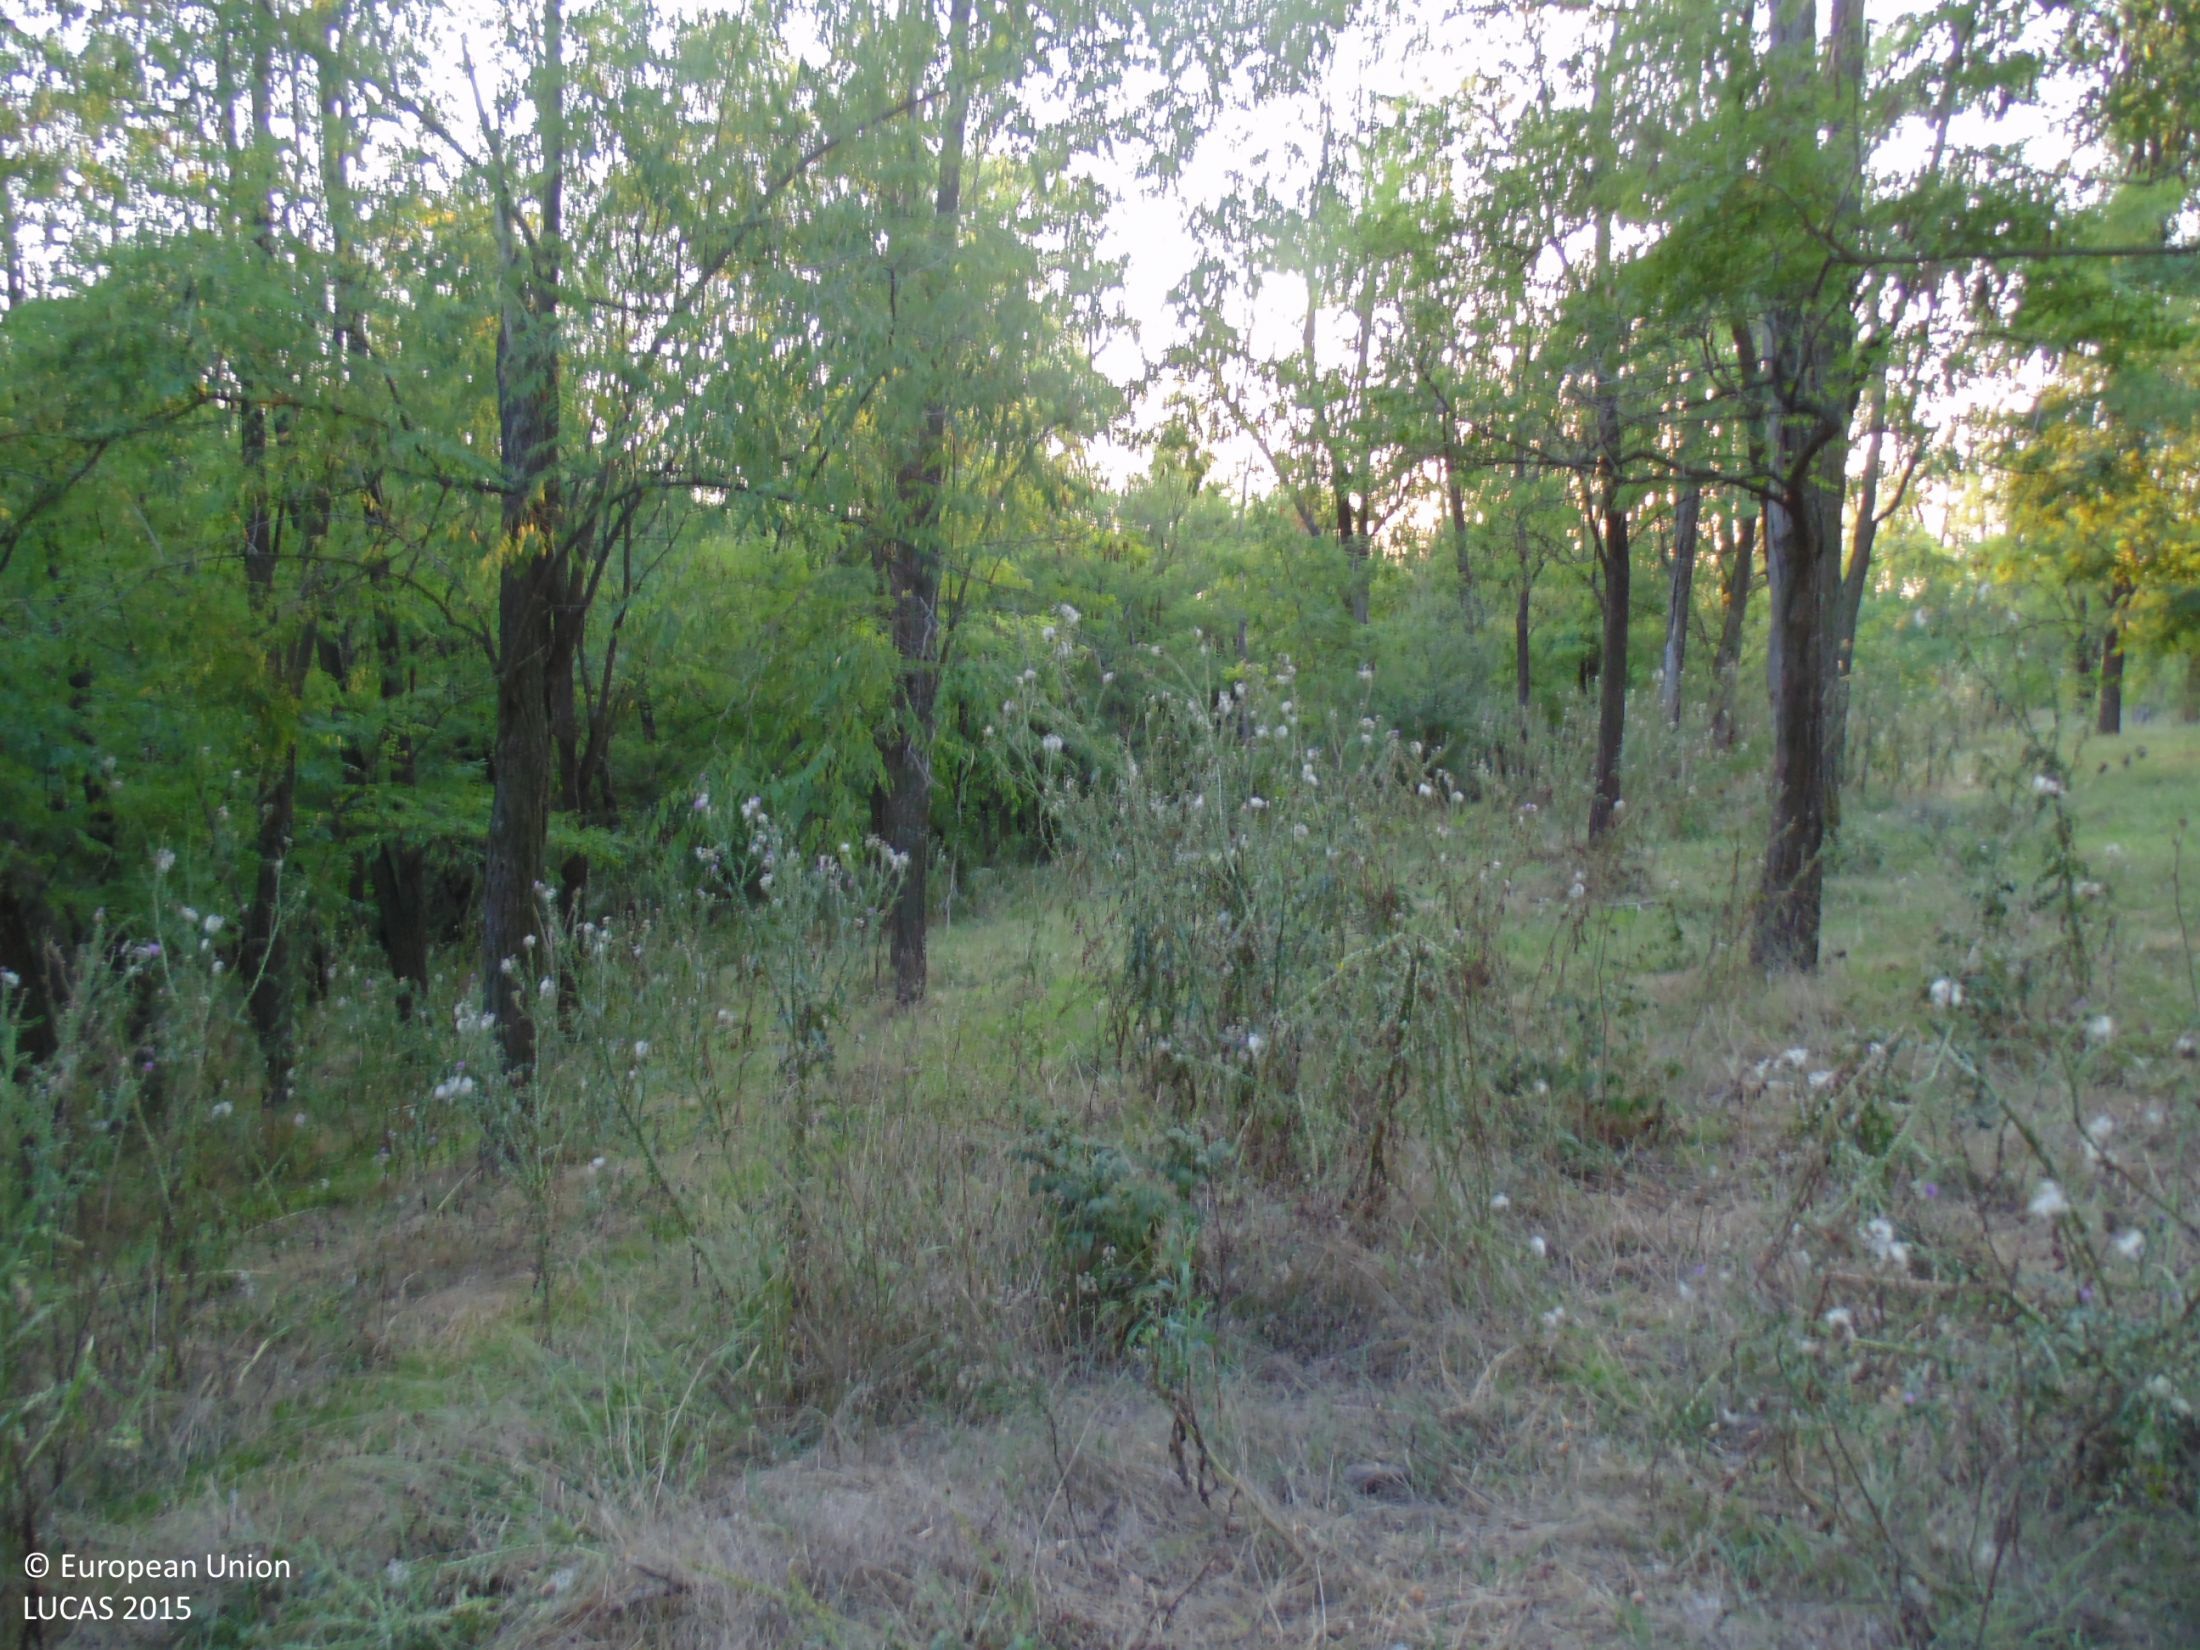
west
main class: Woodland
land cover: Broadleaved woodland
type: mesophytic deciduous forest
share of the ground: > 75 %
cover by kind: broadleaved forest trees 80 %, shrubs 15 %, unconsolidated bare surface 5 %
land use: Forestry
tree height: > 5 m
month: August
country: BG
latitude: 43.6805
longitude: 27.4868
